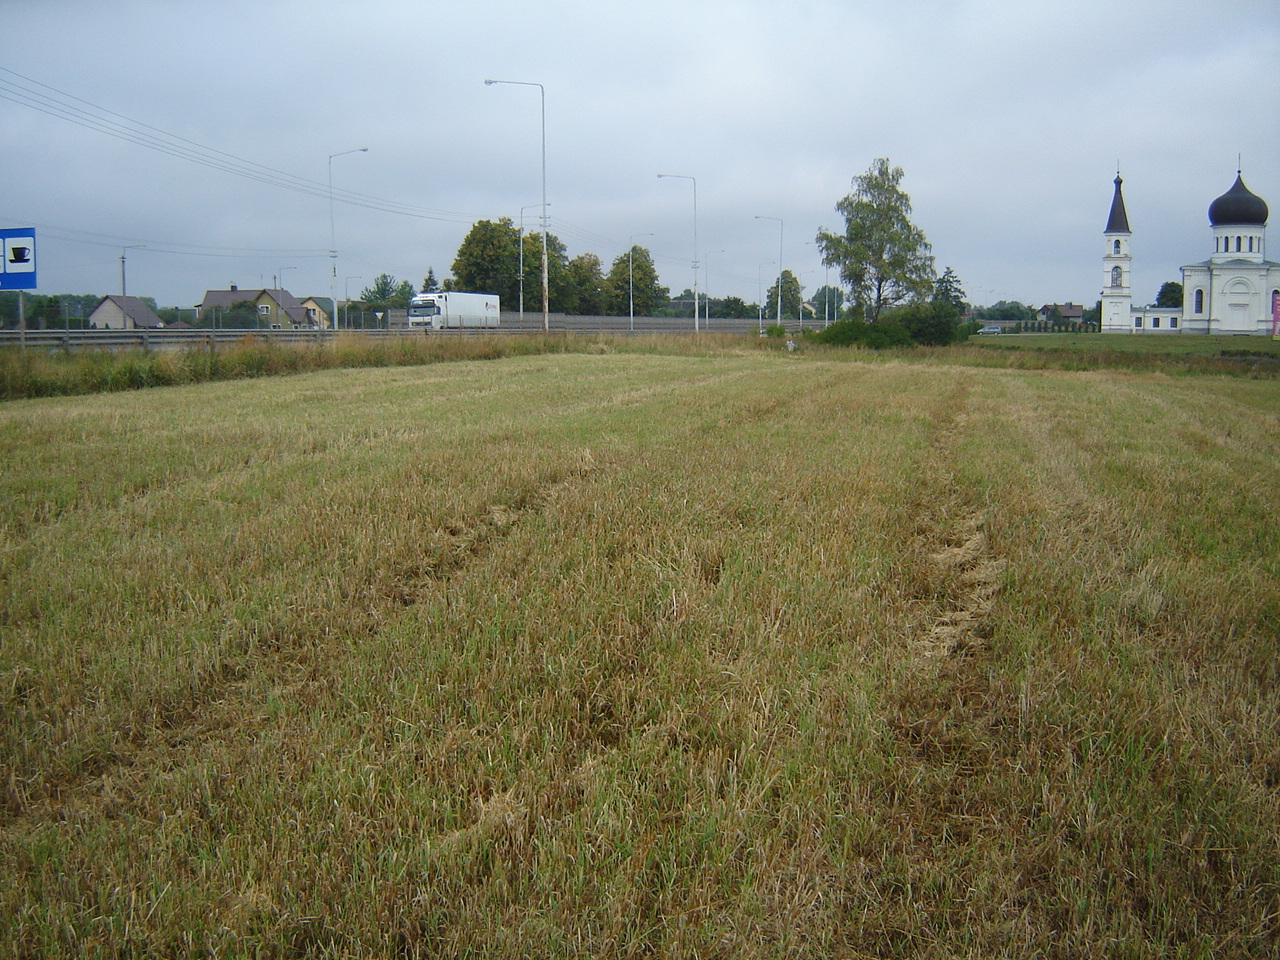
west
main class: Cropland
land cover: Barley
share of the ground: > 75 %
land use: Agriculture (excluding fallow land and kitchen gardens)
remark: Harvested field
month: August
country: LT
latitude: 54.7696
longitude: 24.8302
